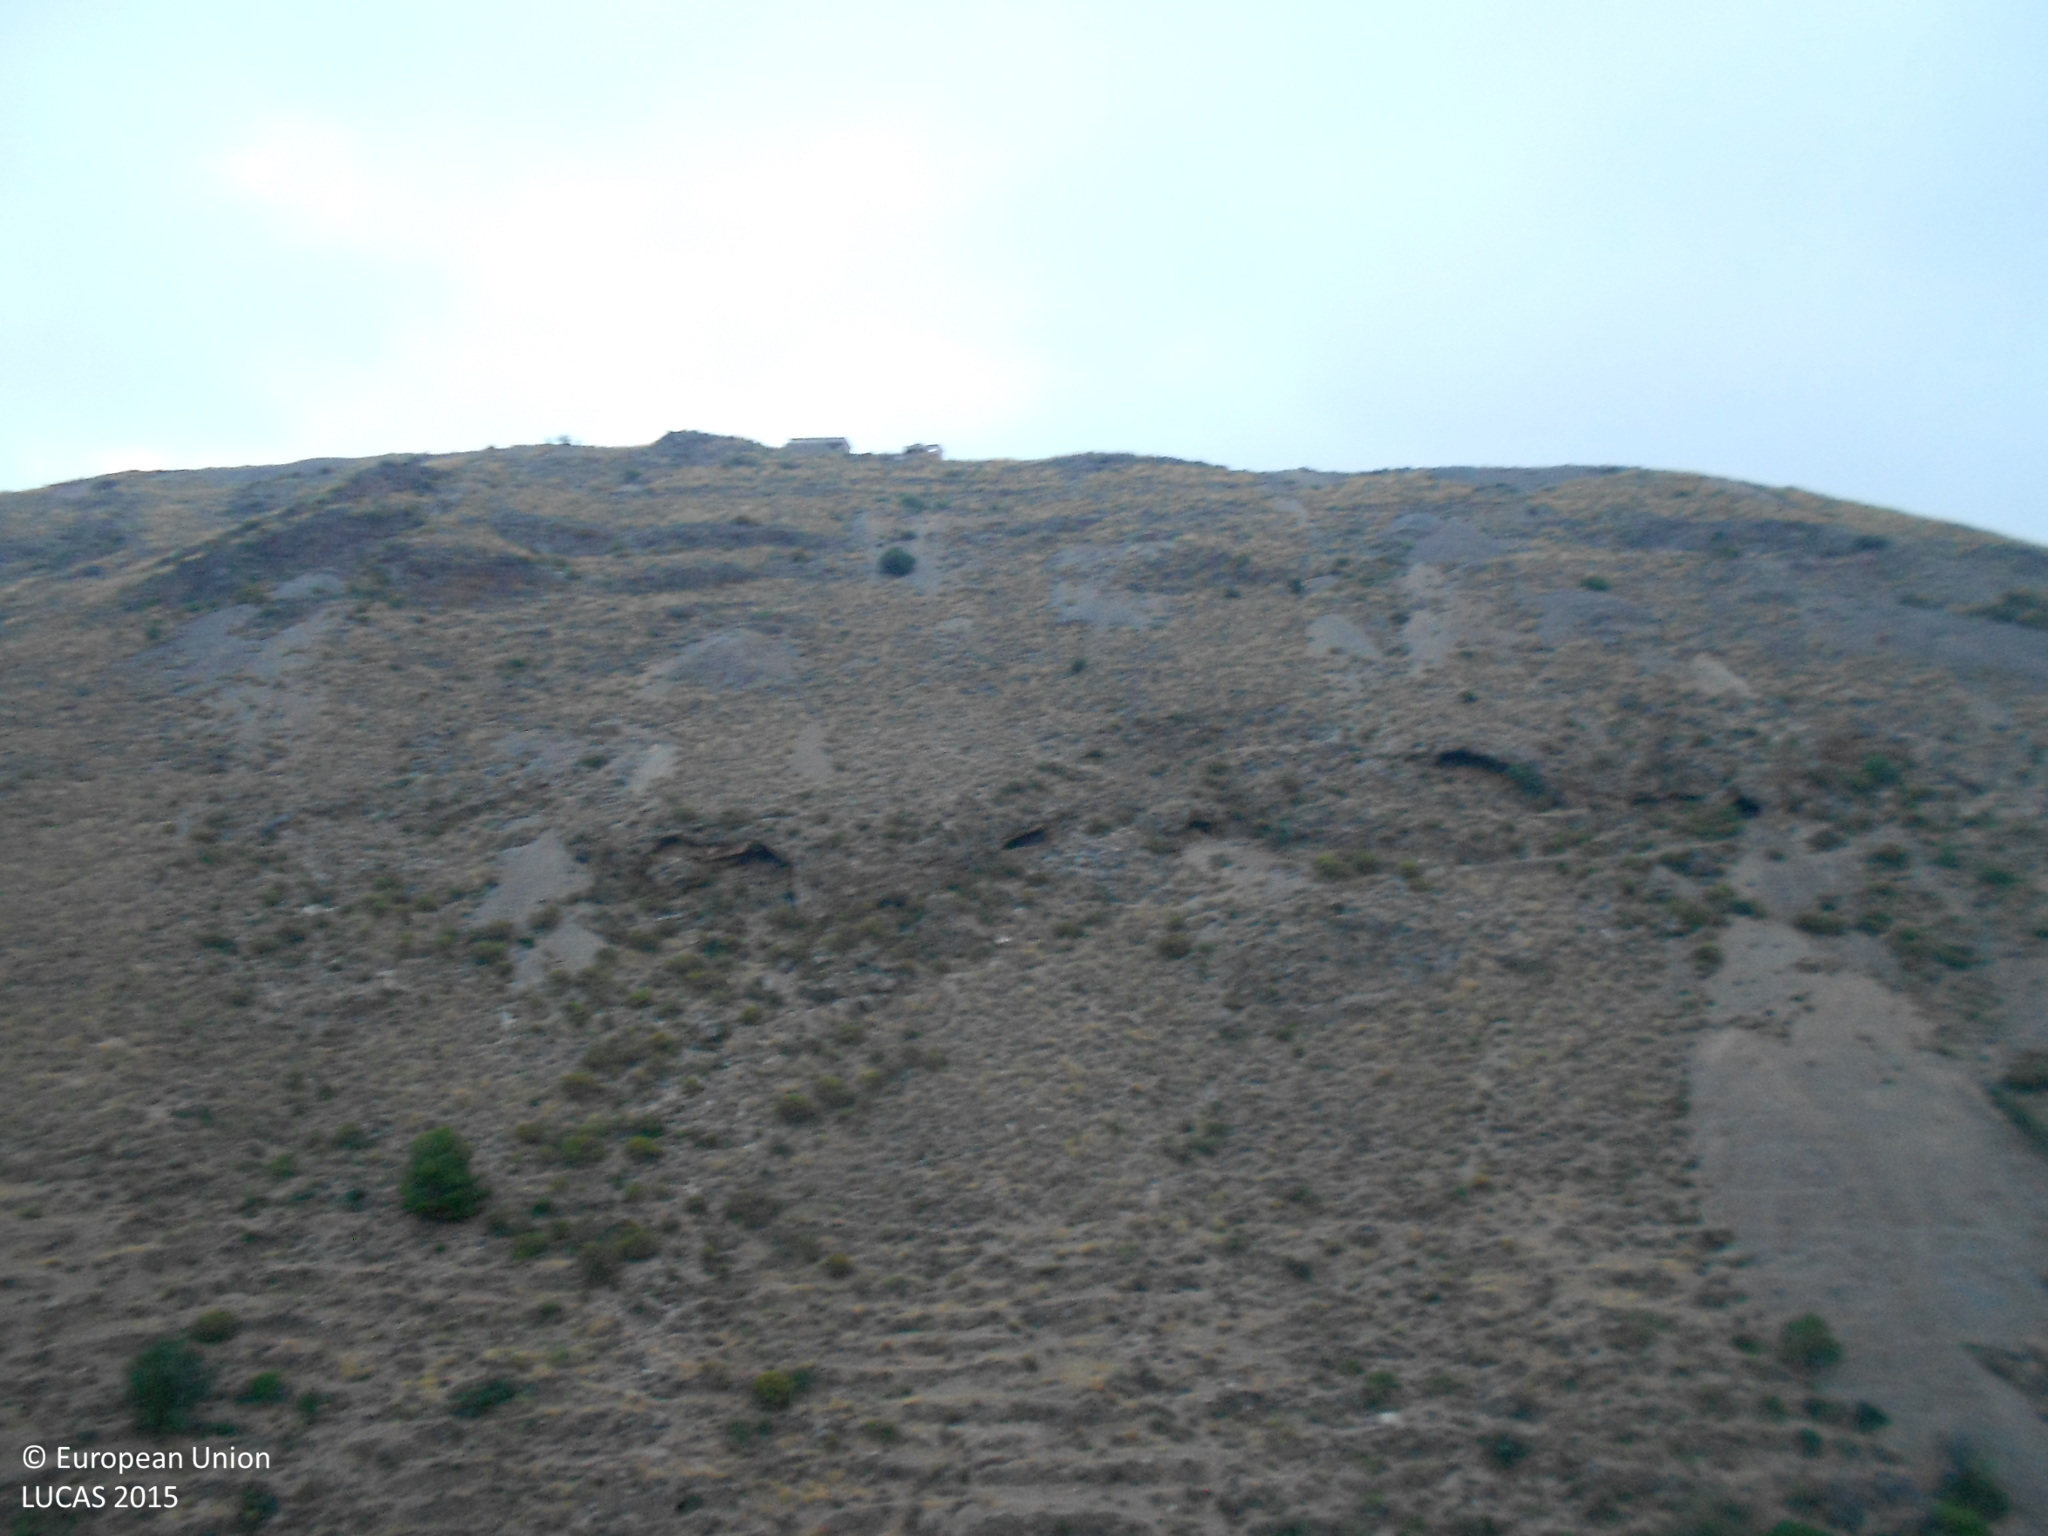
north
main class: Shrubland
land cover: Shrubland without tree cover
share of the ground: 50 - 75 %
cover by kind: shrubs 60 %, herbaceous plants 20 %, consolidated bare surface 20 %
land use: Semi-natural and natural areas not in use
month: July
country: ES
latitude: 36.9858
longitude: -2.8213
